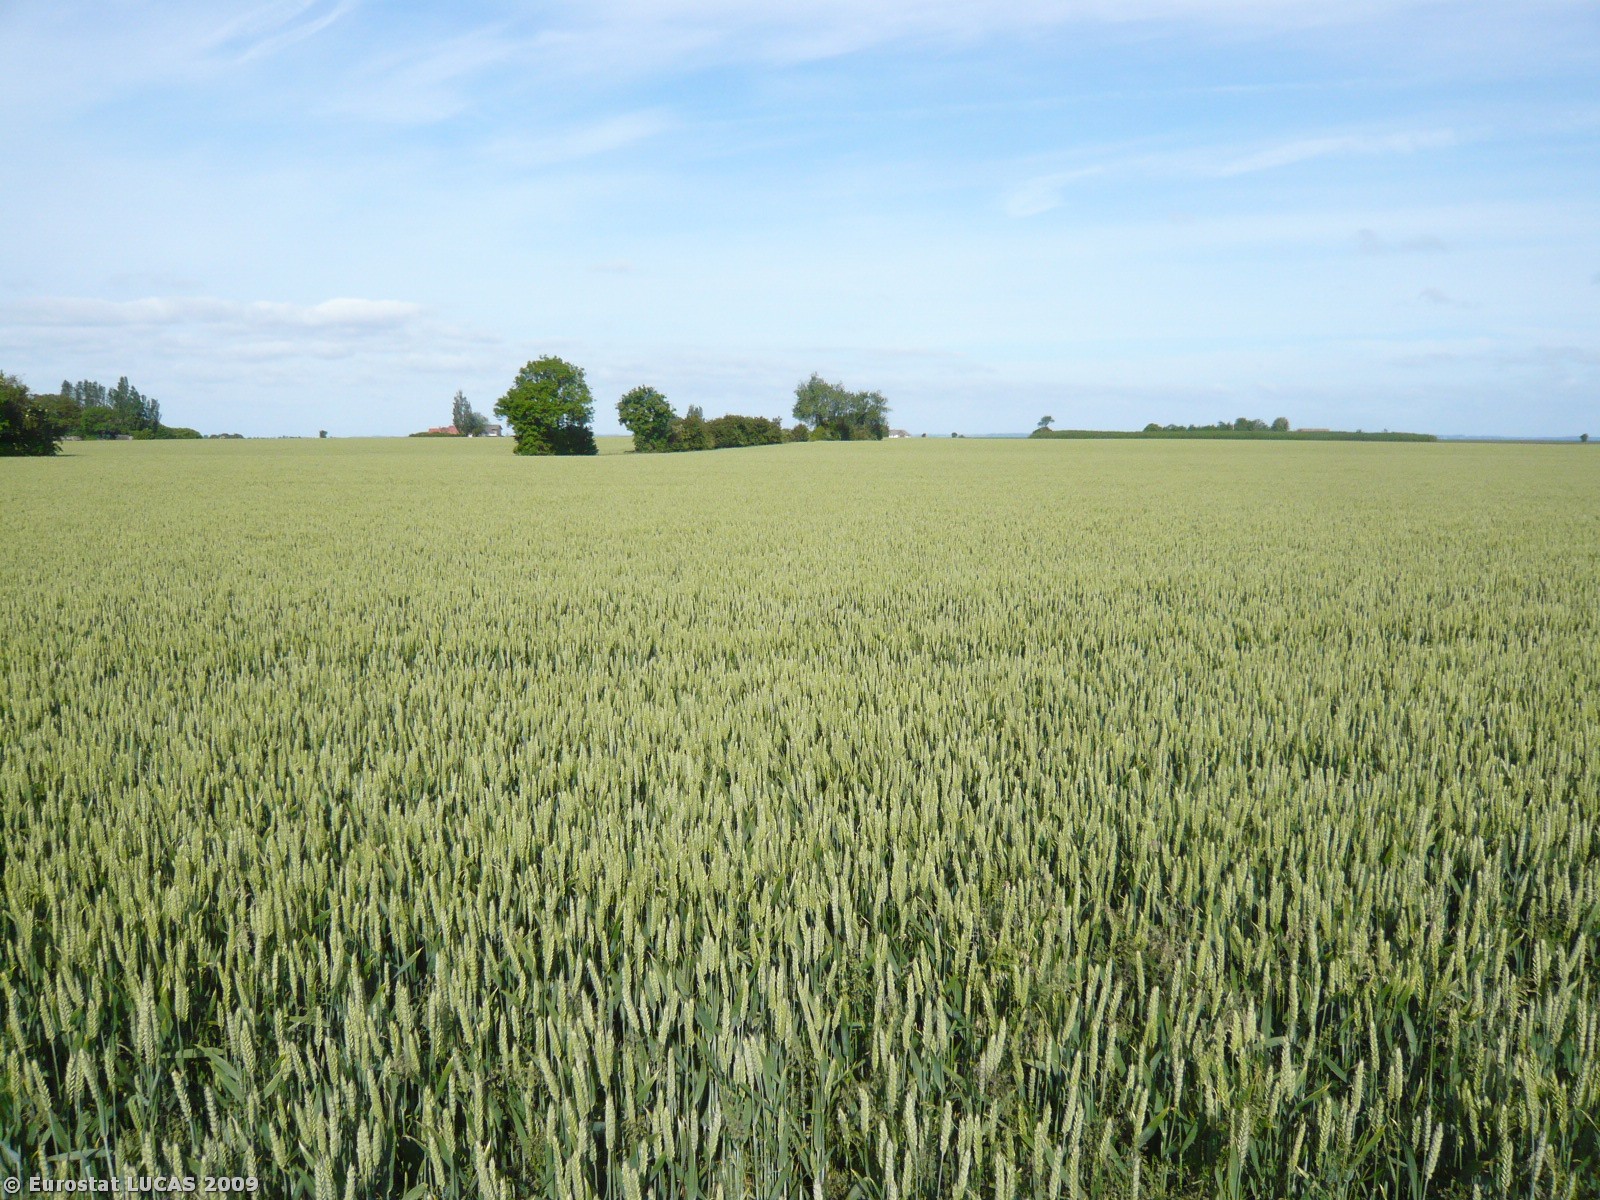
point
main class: Cropland
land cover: Common wheat
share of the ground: > 75 %
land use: Agriculture (excluding fallow land and kitchen gardens)
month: June
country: DK
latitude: 54.9249
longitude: 11.0759
